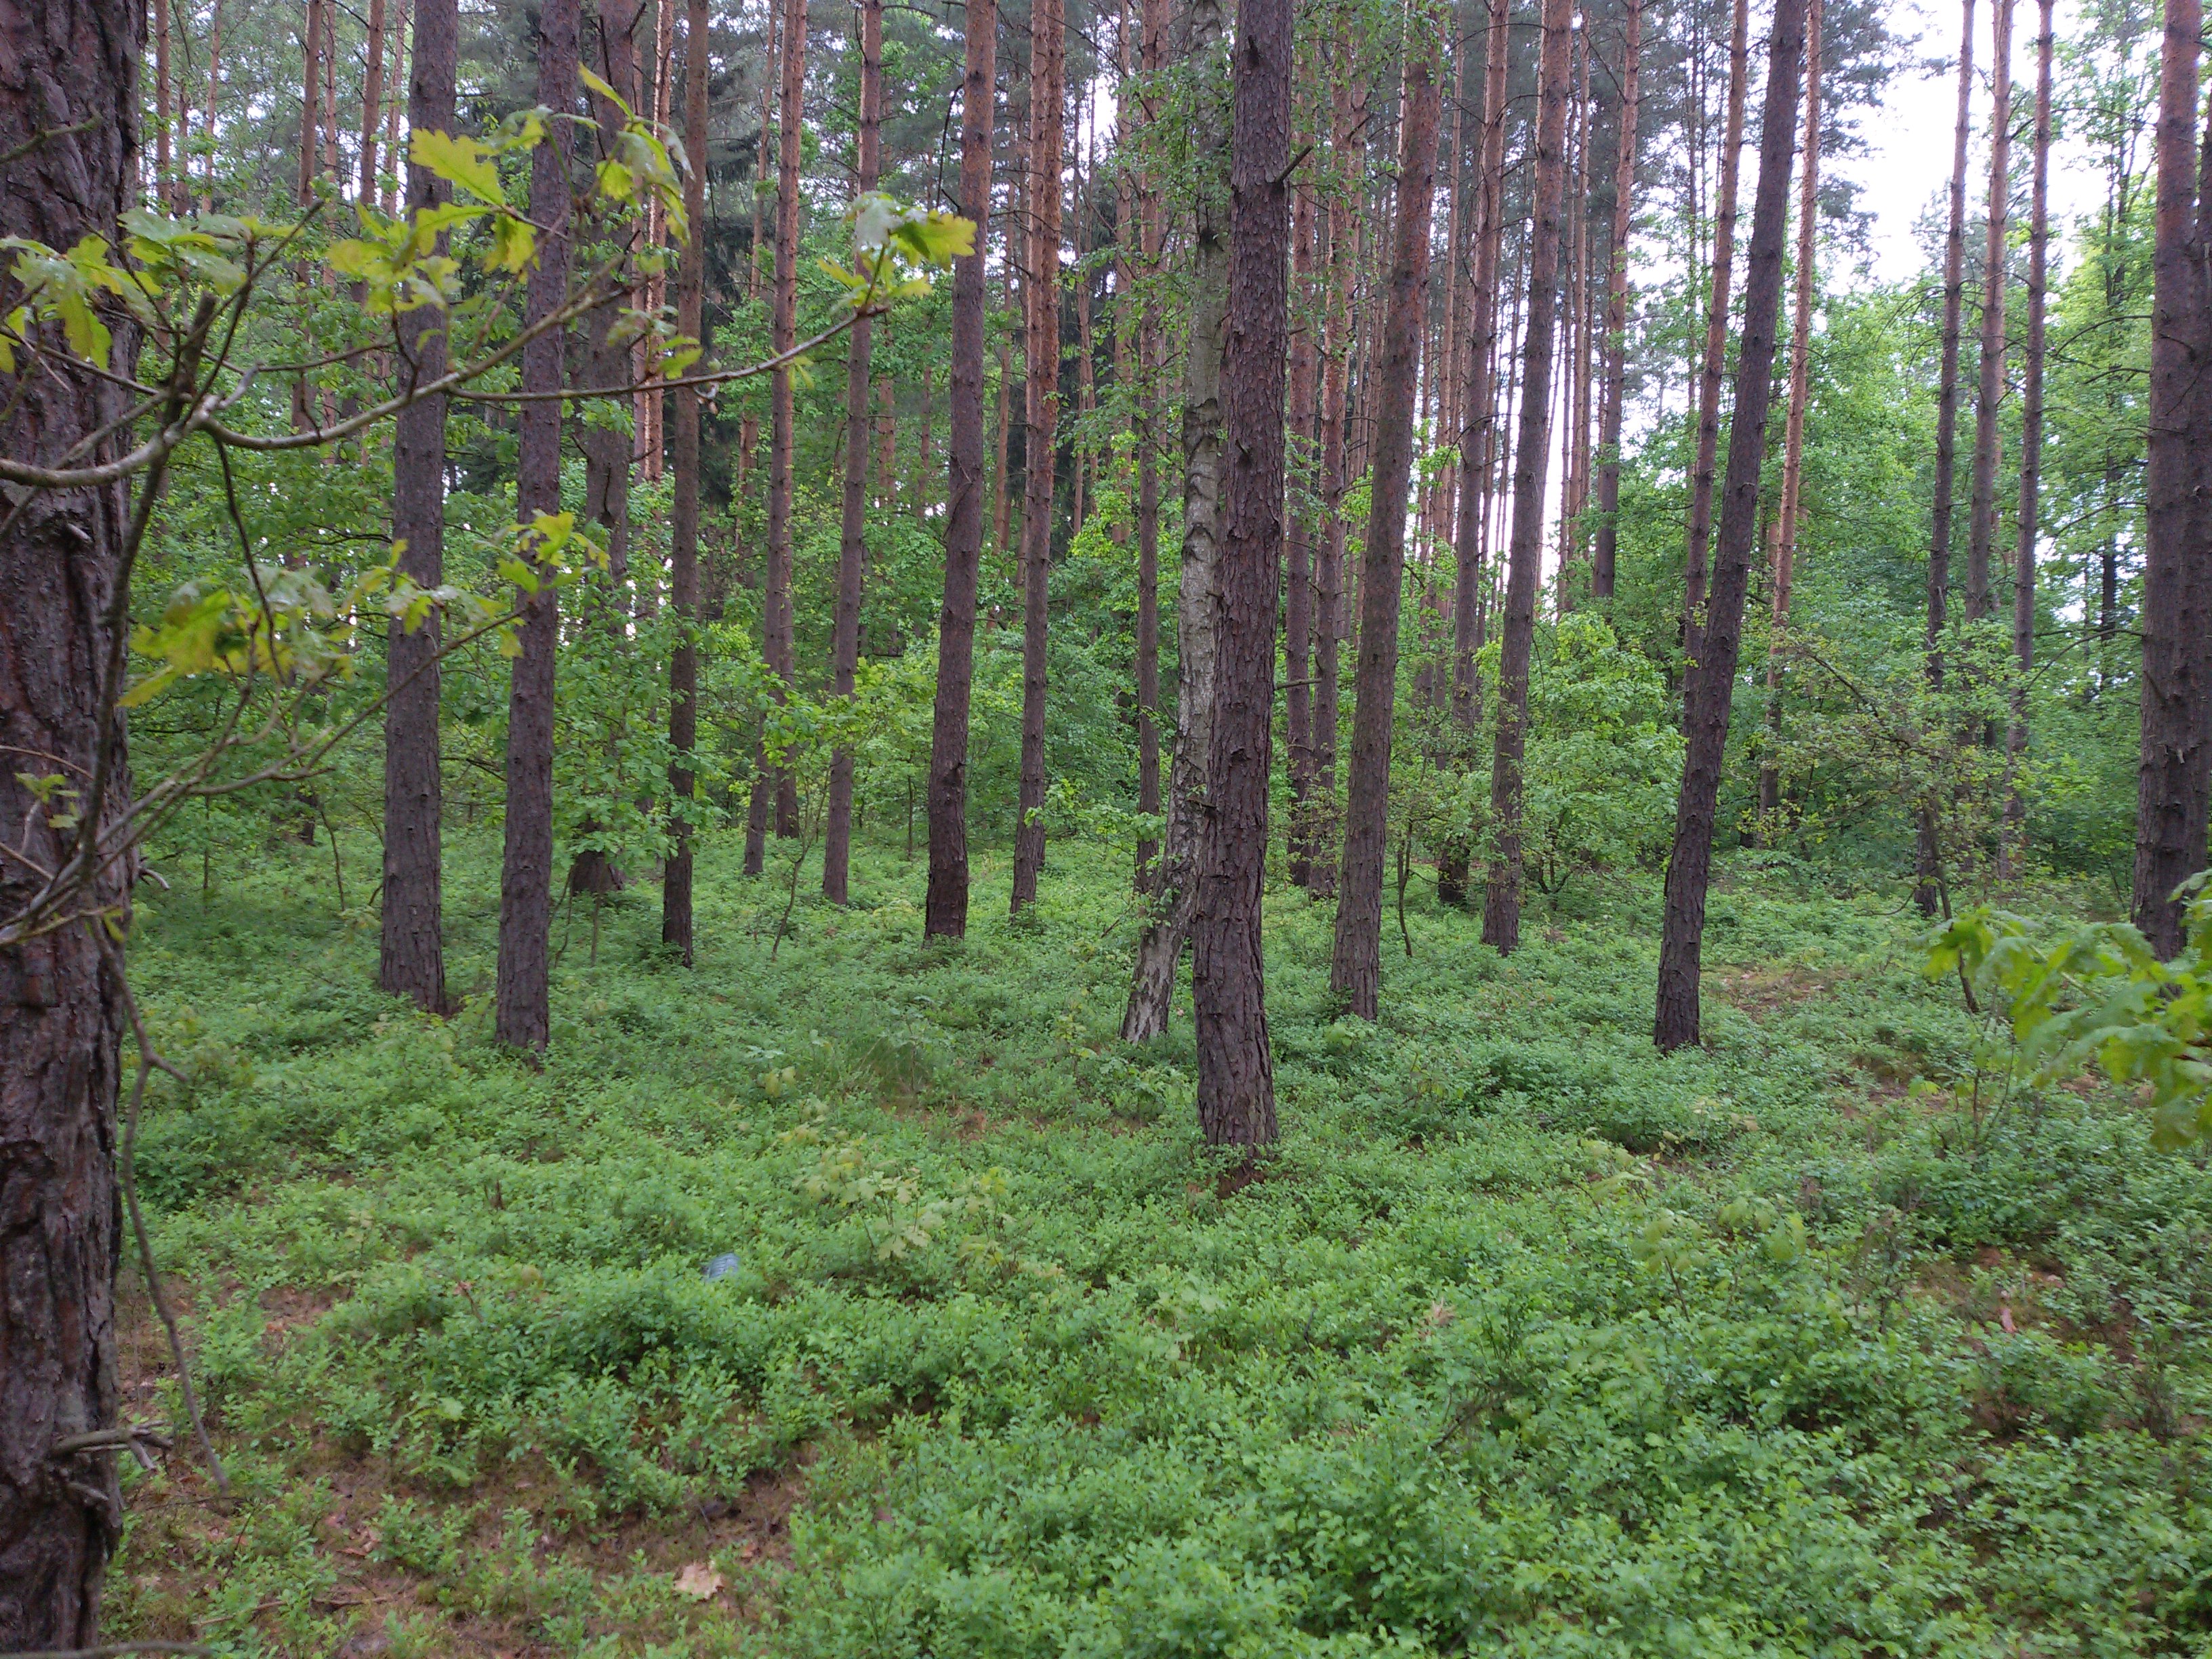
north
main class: Woodland
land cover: Pine dominated coniferous woodland
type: hemiboreal forest and nemoral coniferous forest and mixed broadleaved-coniferous forest
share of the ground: > 75 %
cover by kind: coniferous forest trees 90 %, lichens and mosses 10 %
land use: Forestry
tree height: > 5 m
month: May
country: PL
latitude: 51.3558
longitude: 15.7347
